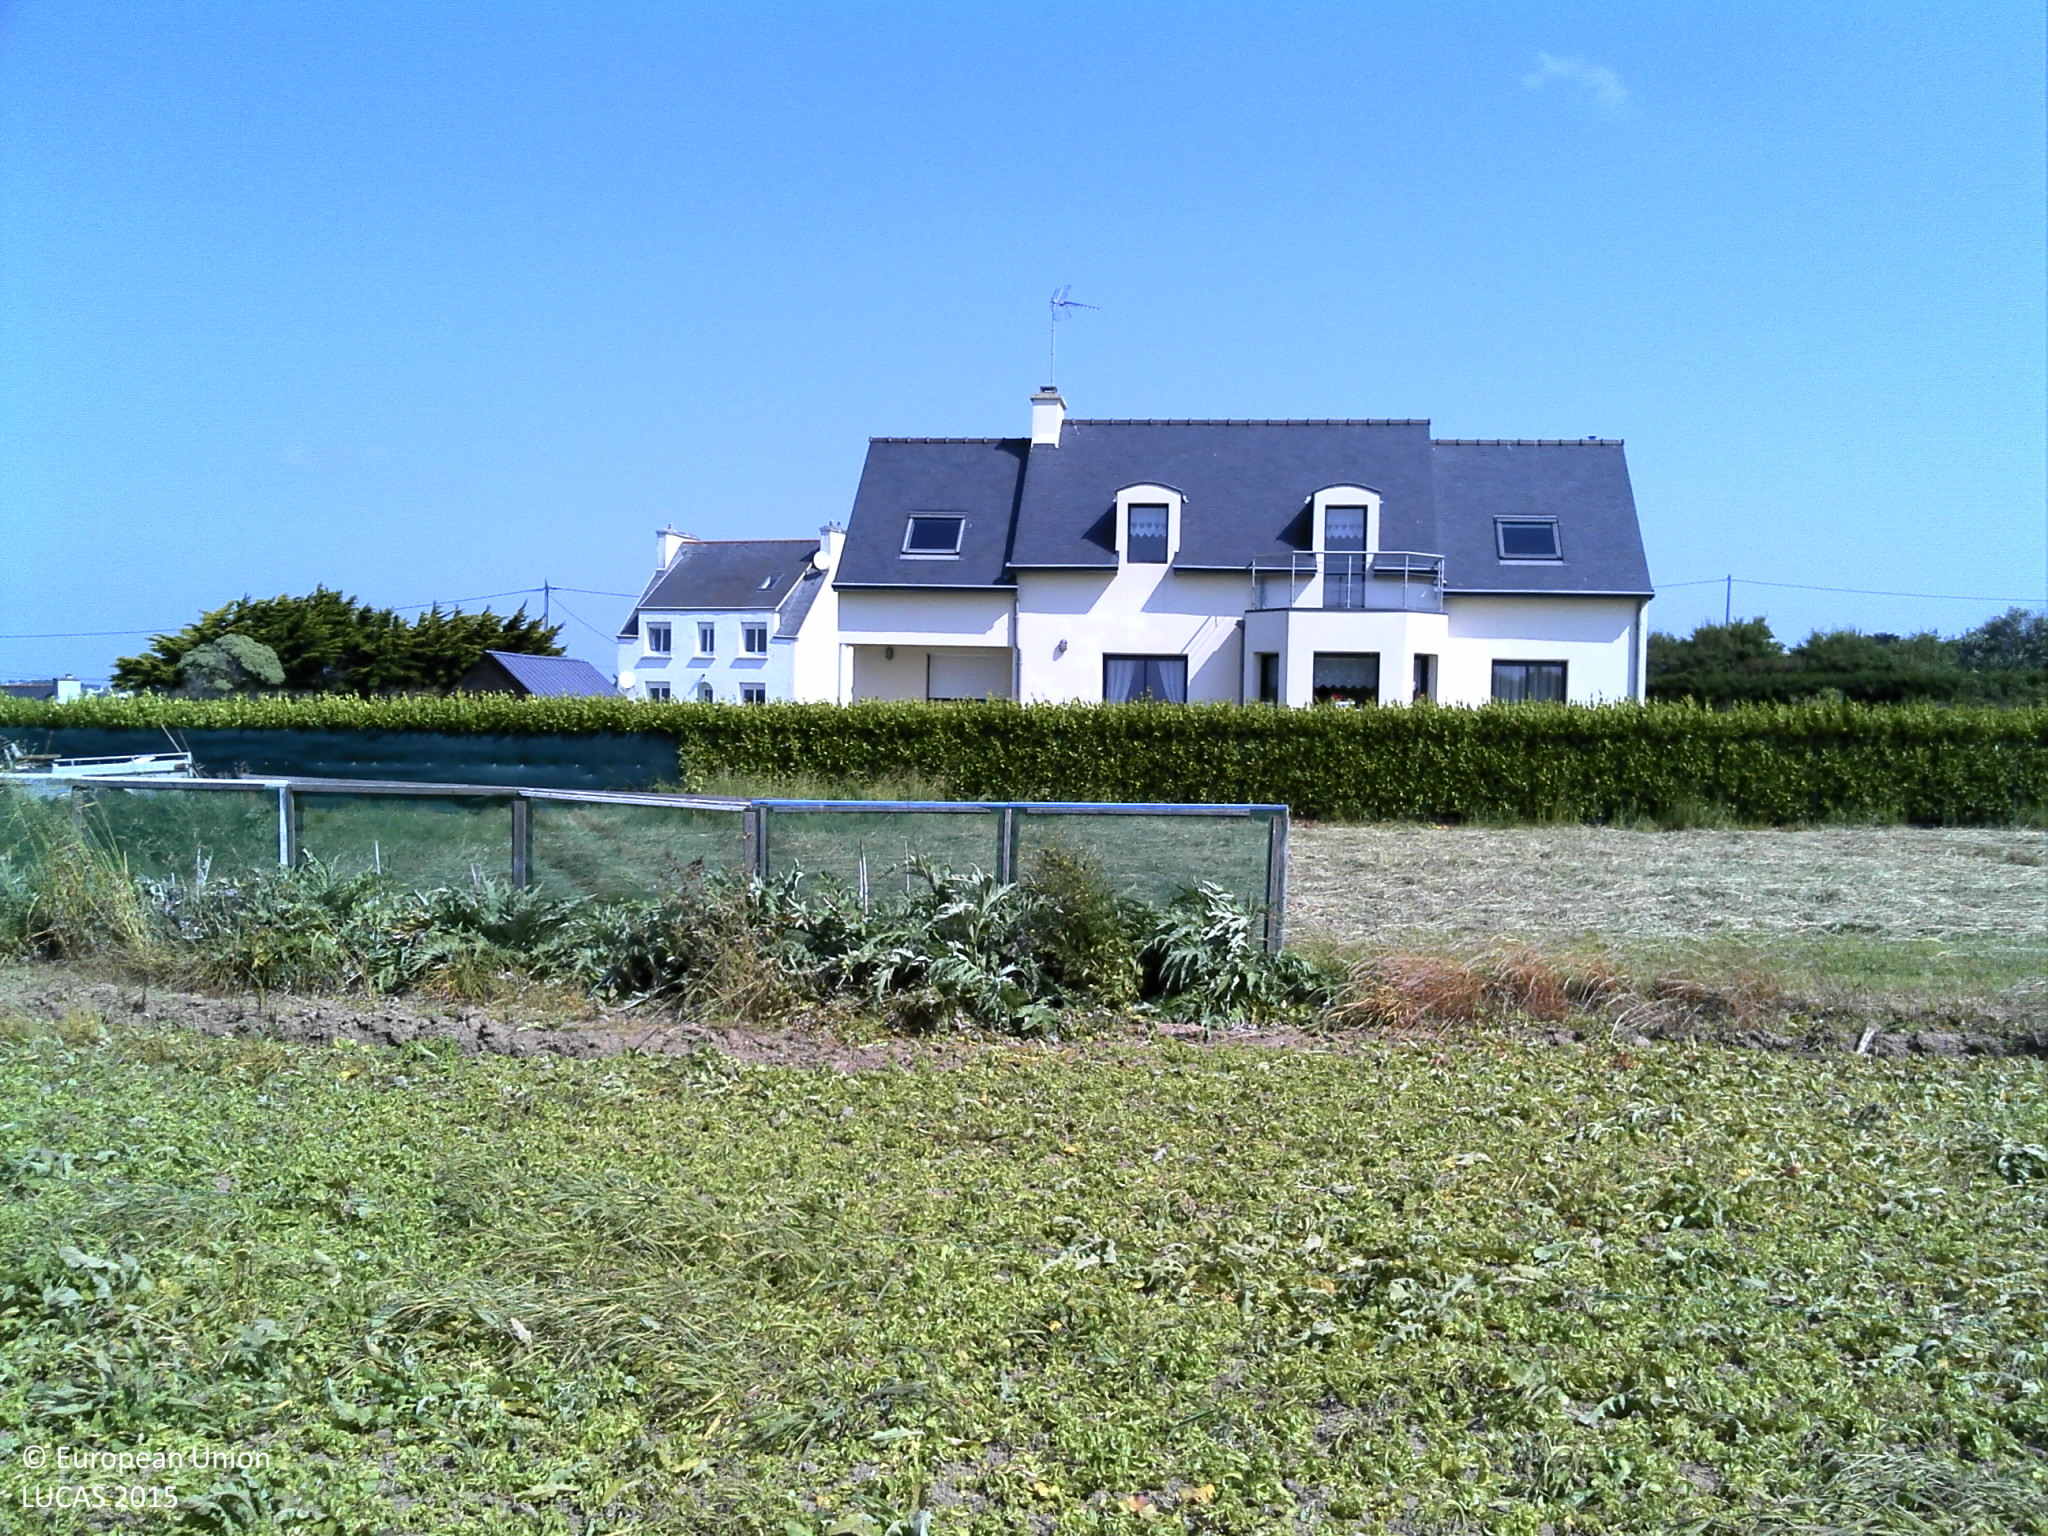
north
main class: Cropland
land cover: Other fresh vegetables
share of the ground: > 75 %
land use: Fallow land
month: June
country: FR
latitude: 47.9788
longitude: -4.4435
